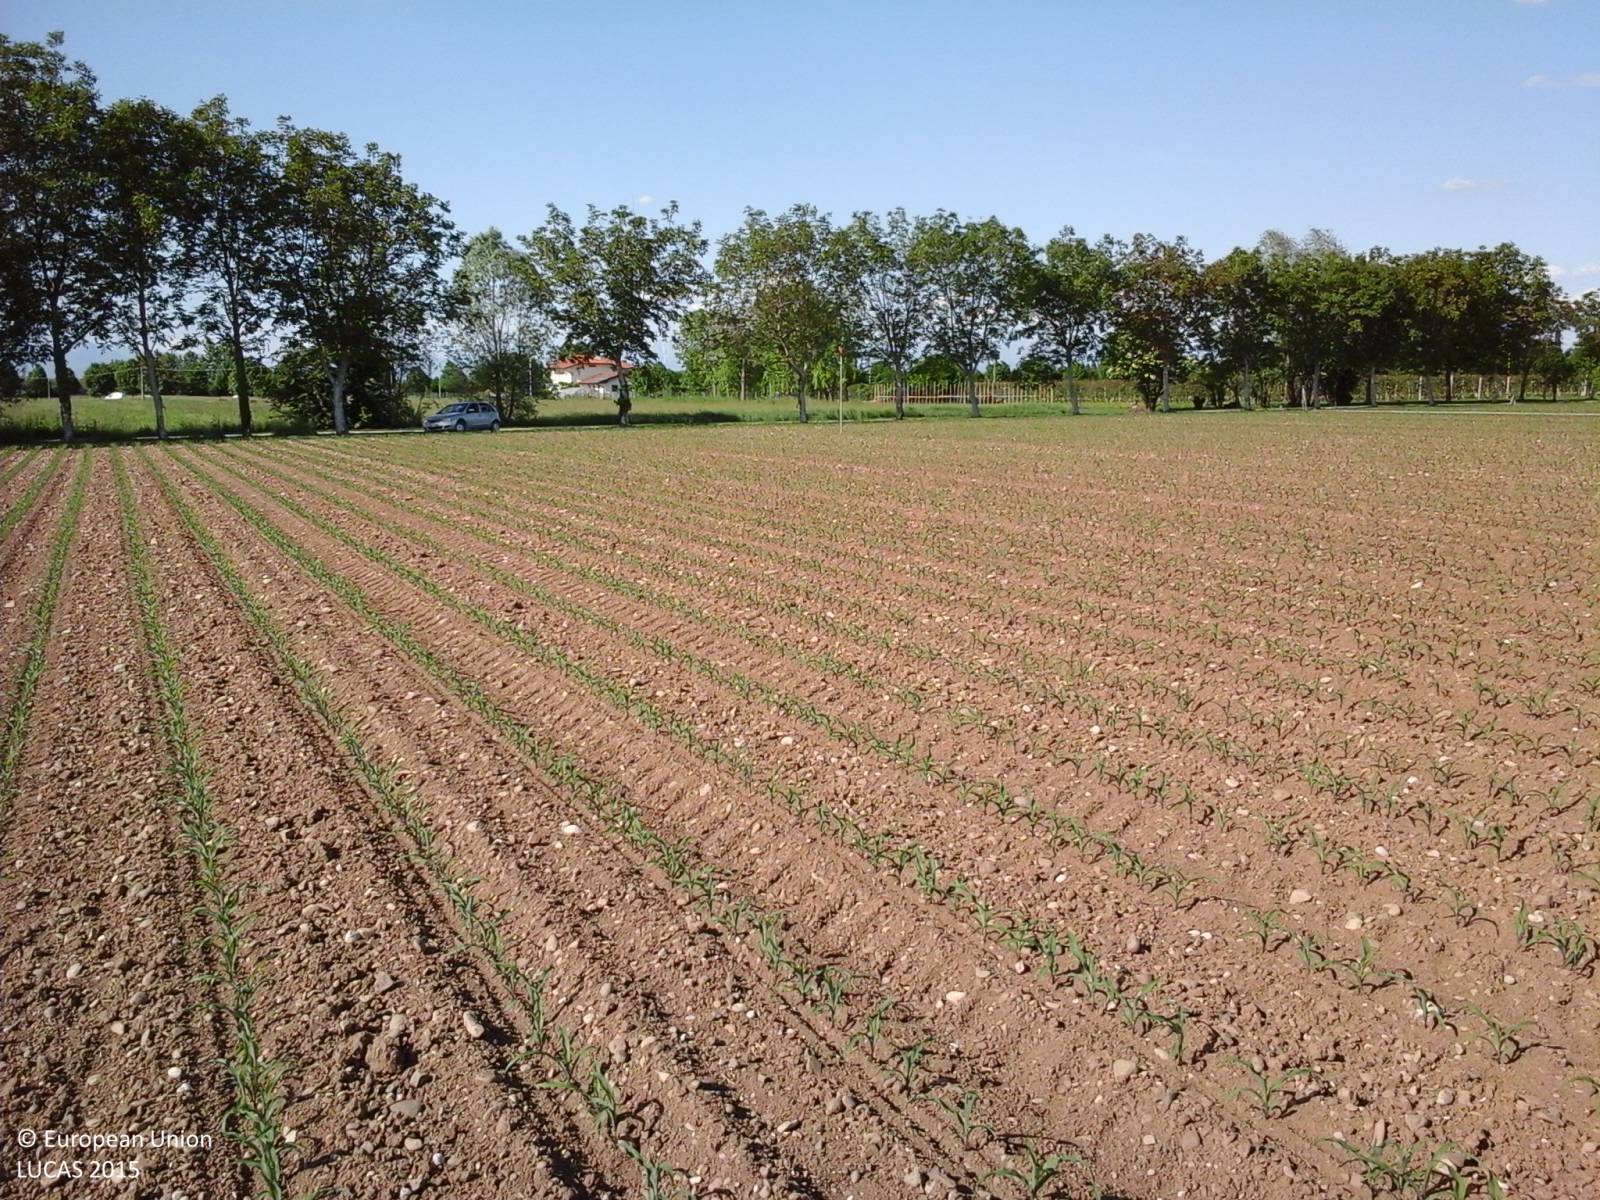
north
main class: Cropland
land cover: Maize
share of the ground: < 10 %
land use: Agriculture (excluding fallow land and kitchen gardens)
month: May
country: IT
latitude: 45.9486
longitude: 13.0022
